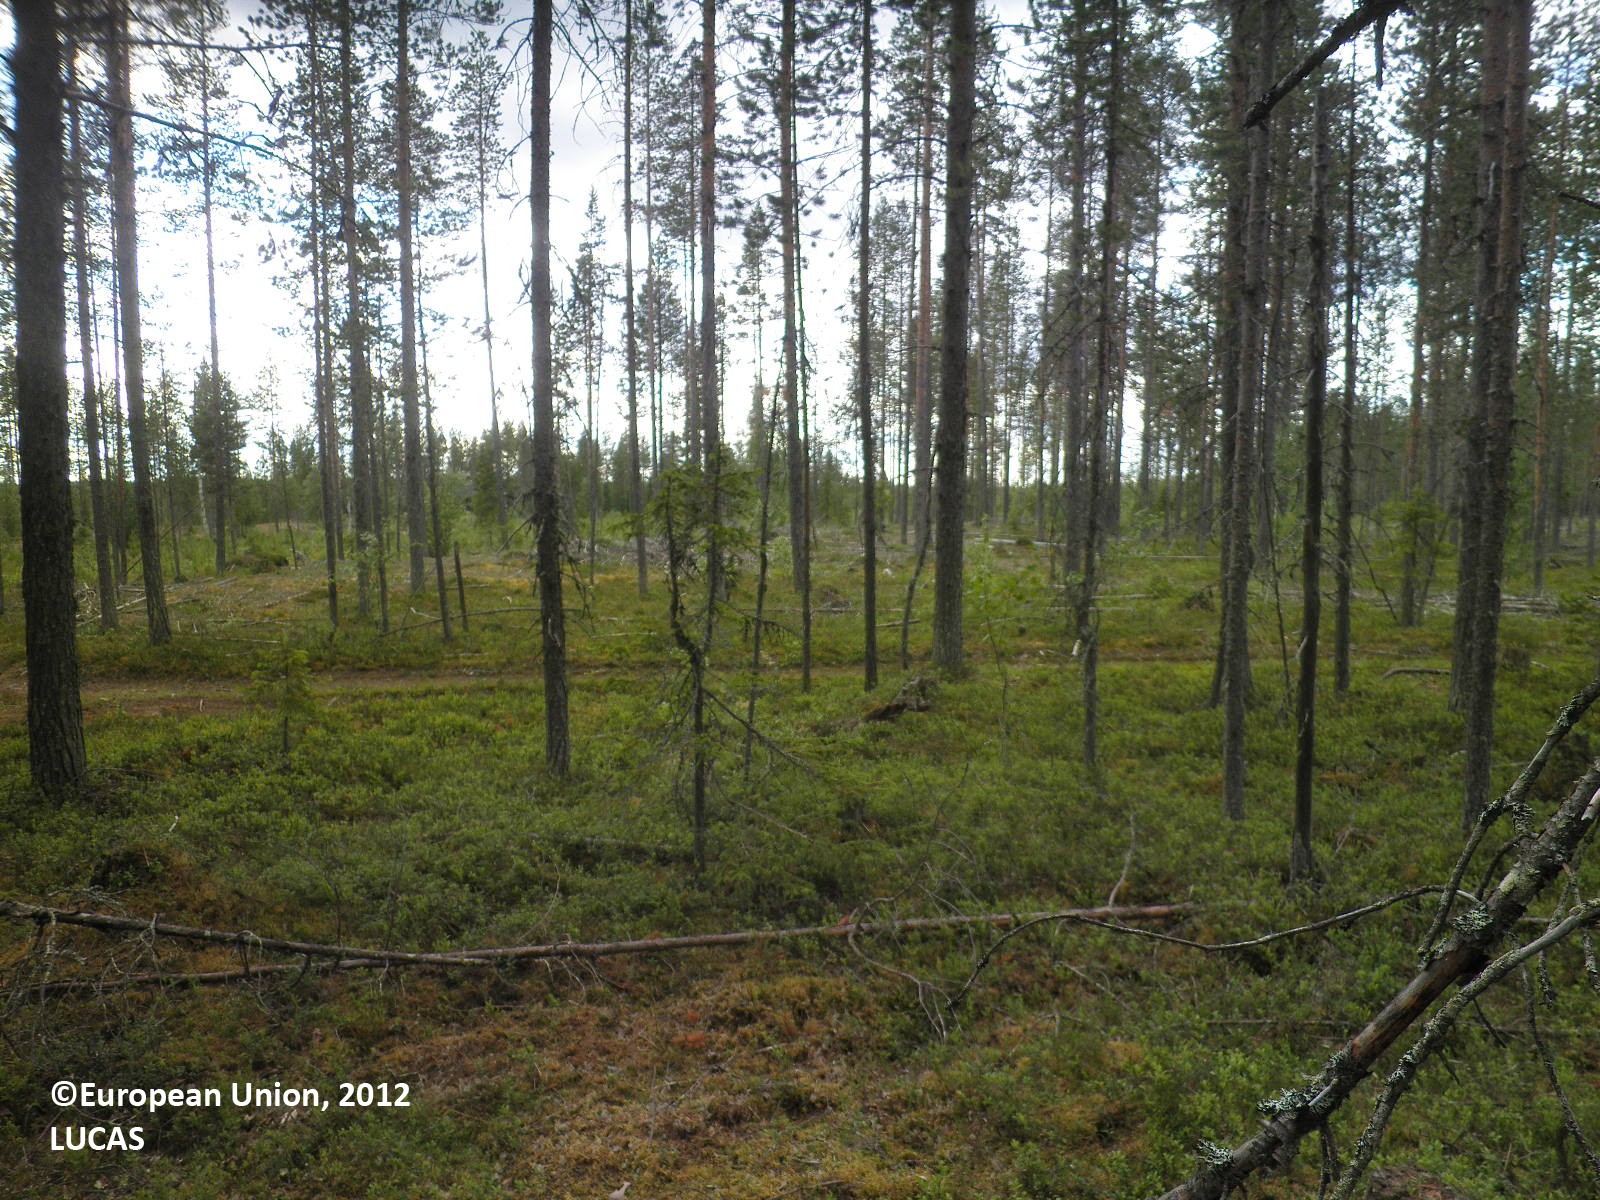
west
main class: Woodland
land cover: Pine dominated coniferous woodland
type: boreal forest
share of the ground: 50 - 75 %
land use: Forestry
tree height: > 5 m
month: July
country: FI
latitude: 67.5407
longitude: 25.8898
